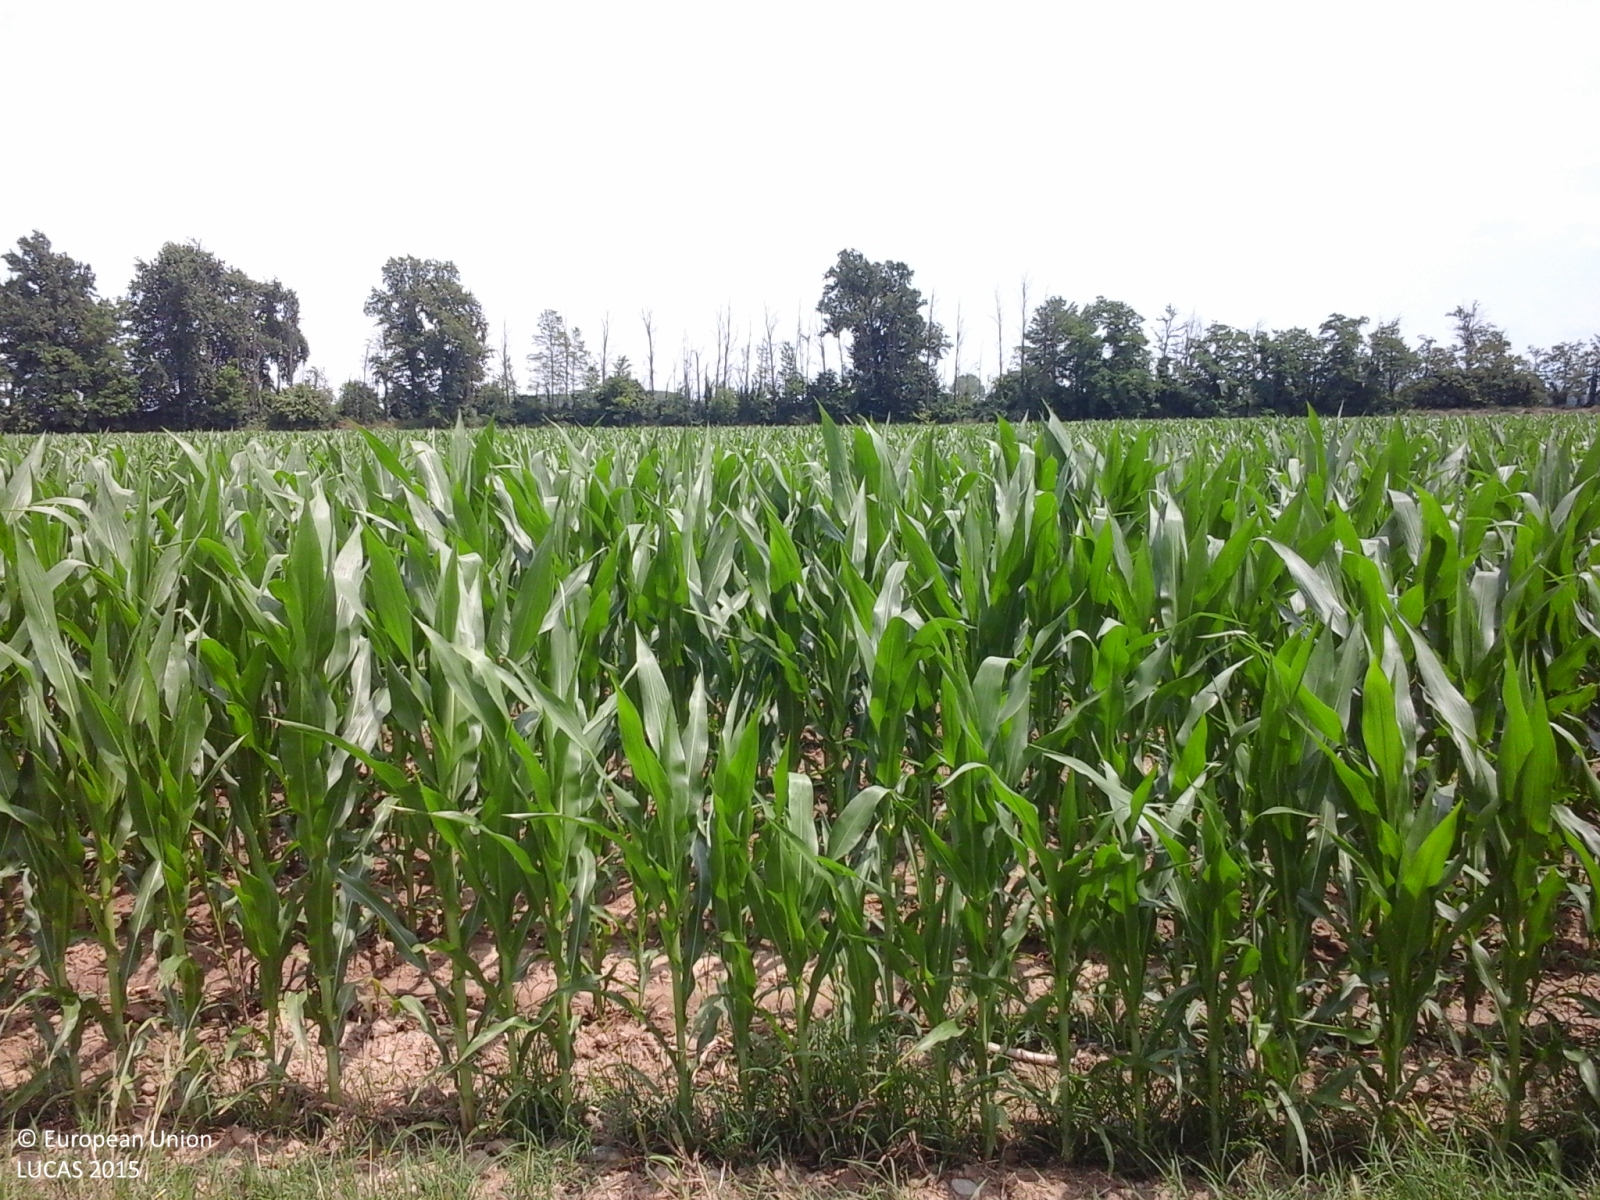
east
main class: Cropland
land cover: Maize
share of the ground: > 75 %
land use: Agriculture (excluding fallow land and kitchen gardens)
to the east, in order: Maize; Grass margins; Tracks; Grass margins; Maize; Electric lines; Maize
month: June
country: IT
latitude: 44.8107
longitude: 8.6498
